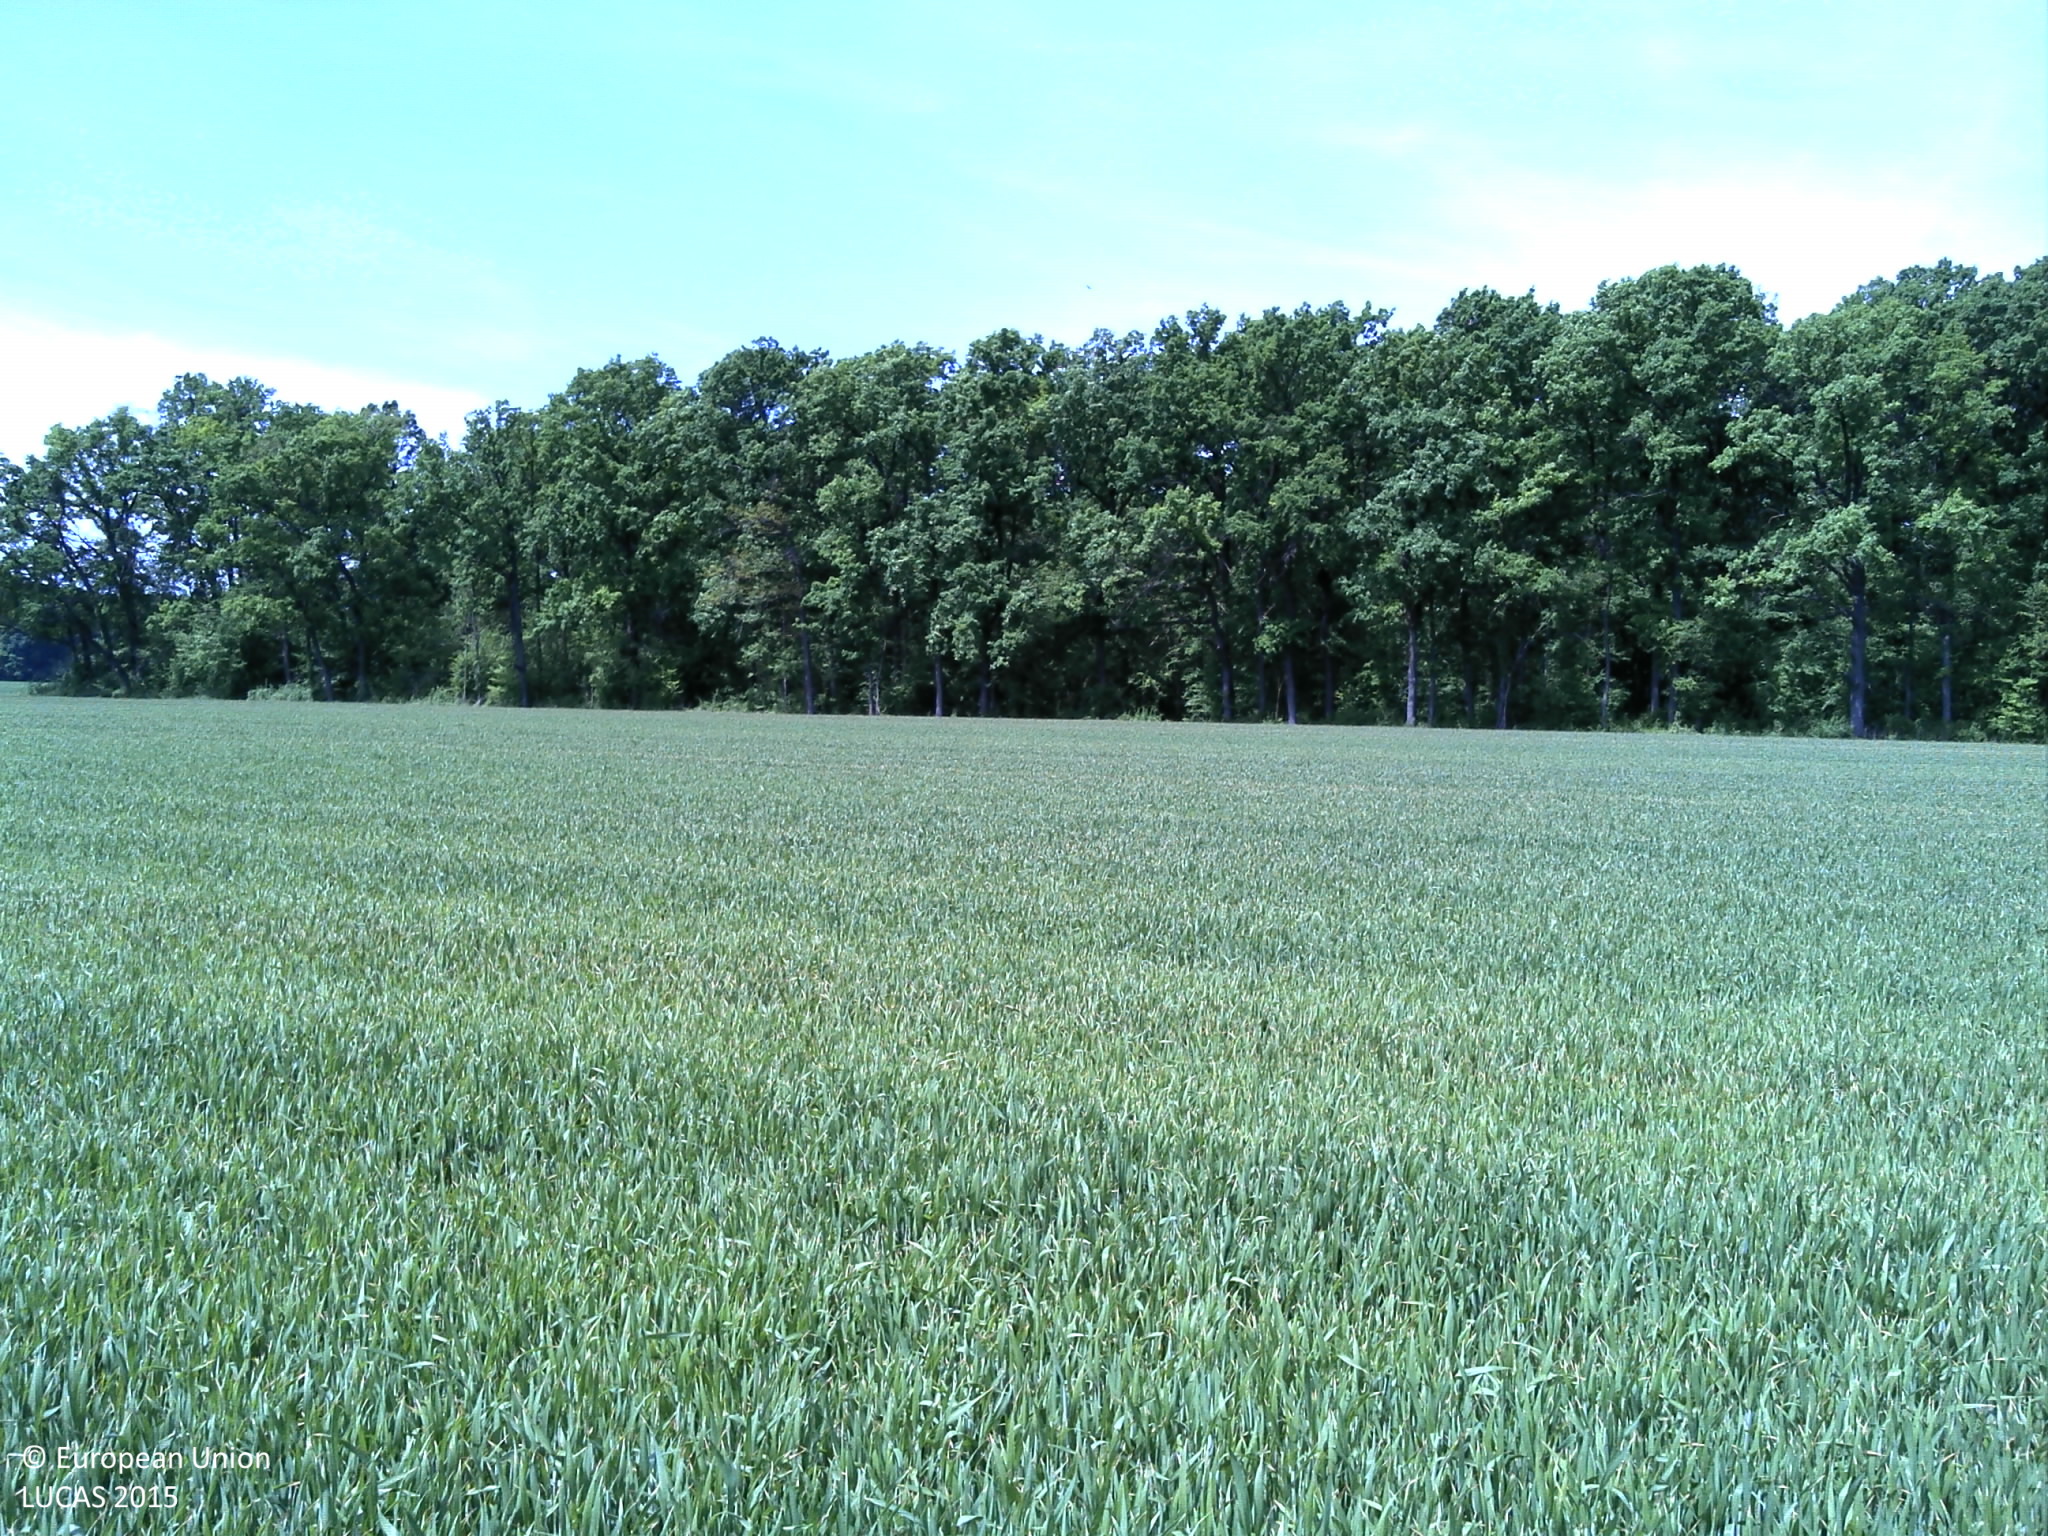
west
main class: Cropland
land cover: Common wheat
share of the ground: > 75 %
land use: Agriculture (excluding fallow land and kitchen gardens)
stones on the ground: < 10 %
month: May
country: HR
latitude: 45.2378
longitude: 18.8864
